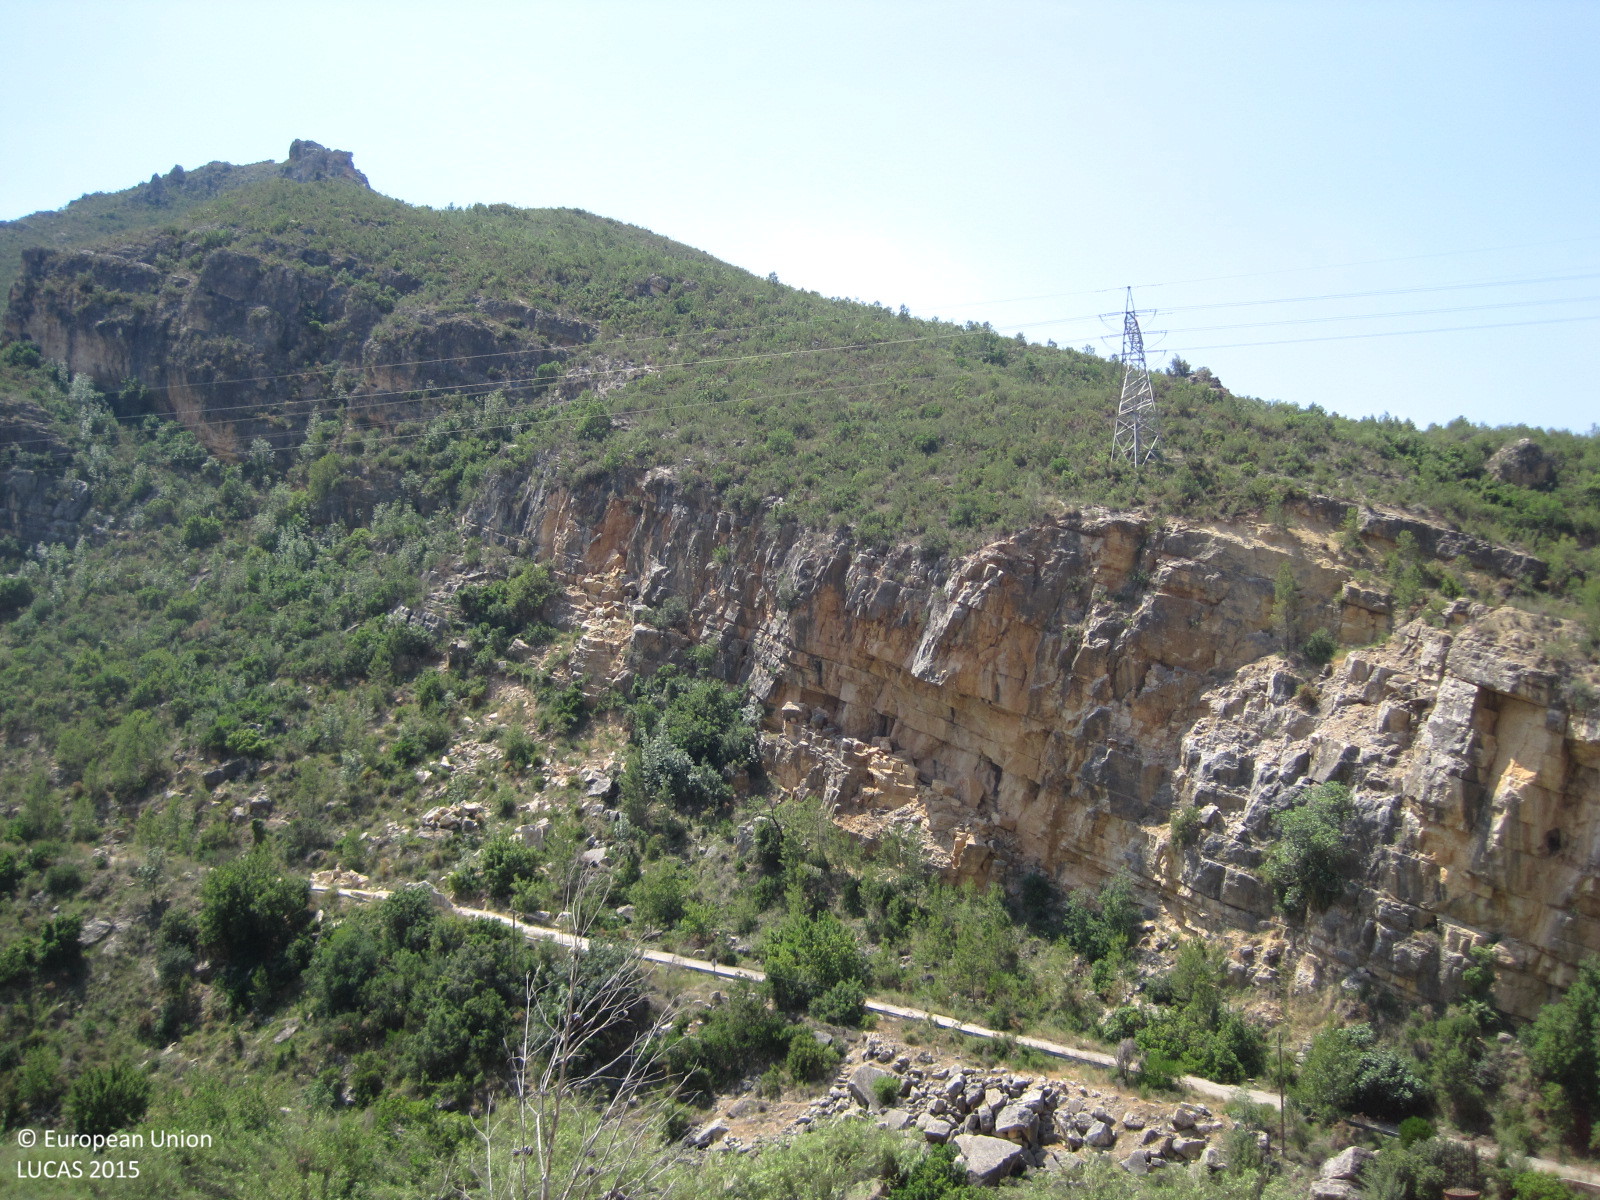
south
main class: Shrubland
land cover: Shrubland without tree cover
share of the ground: 25 - 50 %
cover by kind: lichens and mosses 50 %, shrubs 40 %, herbaceous plants 10 %
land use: Semi-natural and natural areas not in use
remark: Burnt area
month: June
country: ES
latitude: 39.2693
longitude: -0.7881
